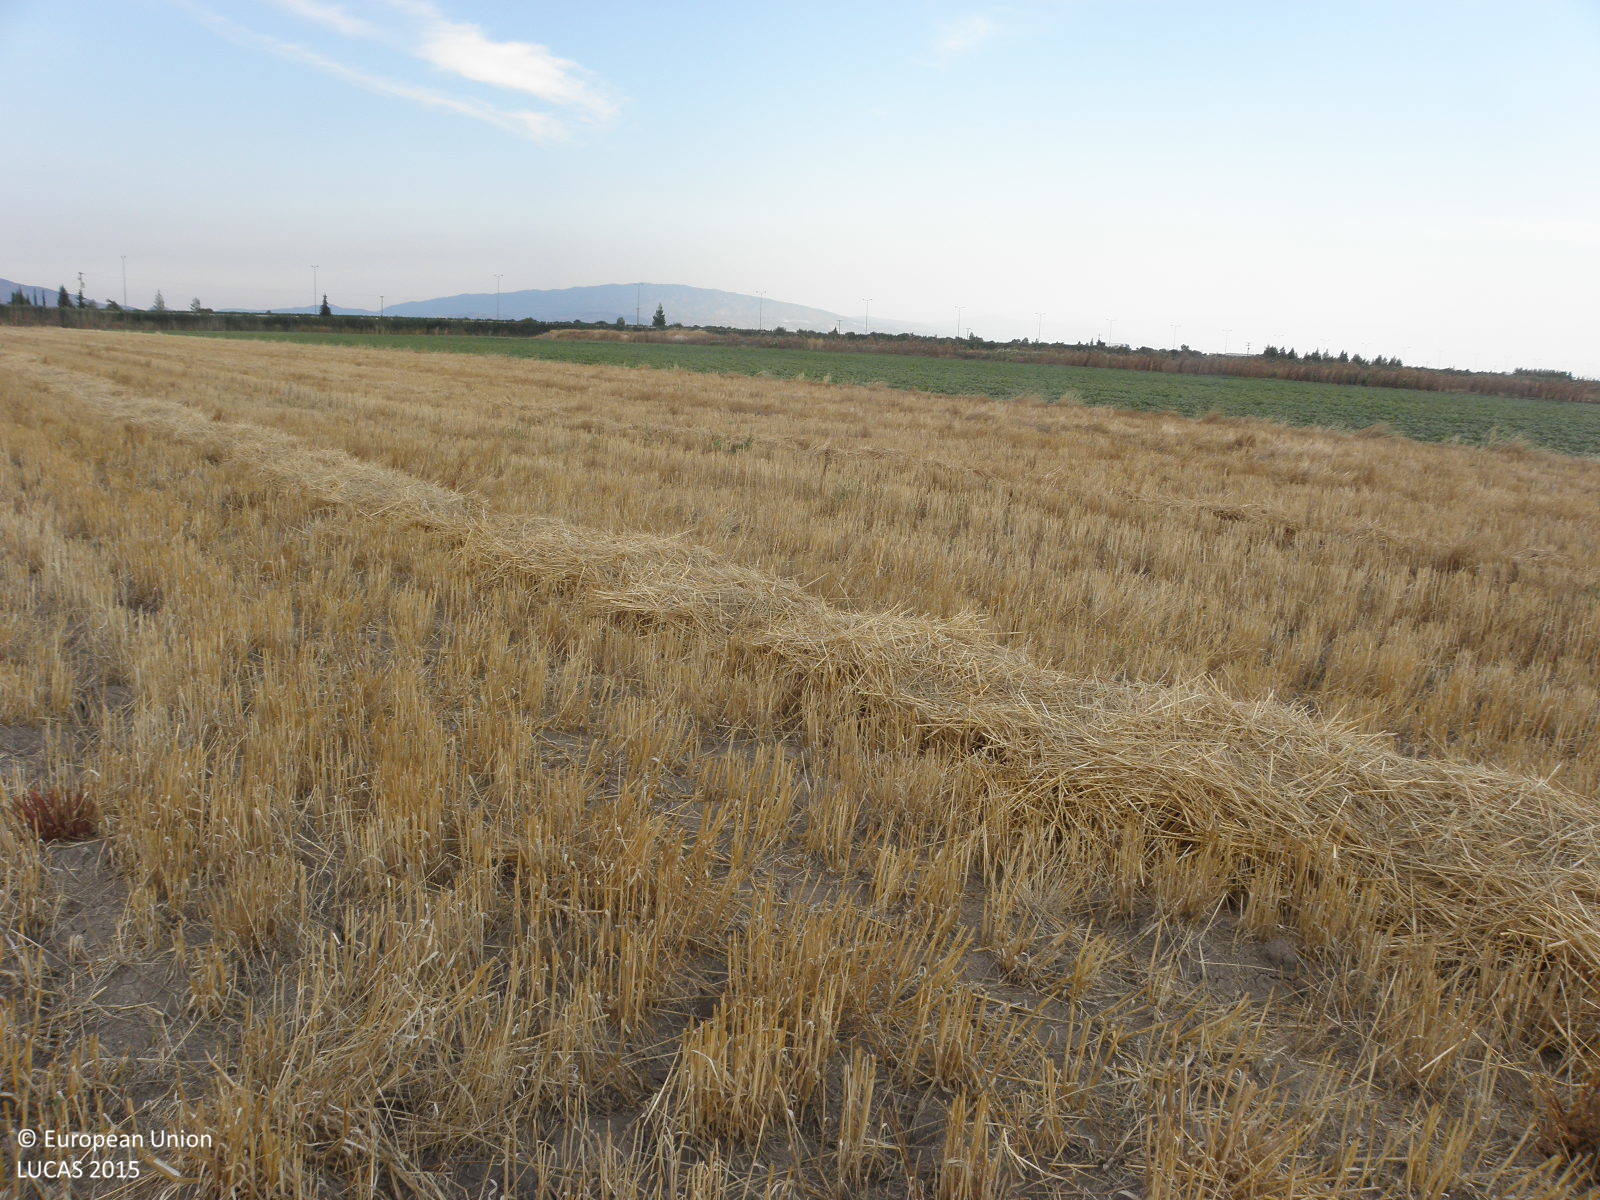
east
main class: Cropland
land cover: Barley
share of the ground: < 10 %
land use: Agriculture (excluding fallow land and kitchen gardens)
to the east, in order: Barley; Cotton; Inland marshes; Ditches and canals; Inland marshes; Spontaneously vegetated surfaces
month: June
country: GR
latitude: 39.6658
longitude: 22.4985
